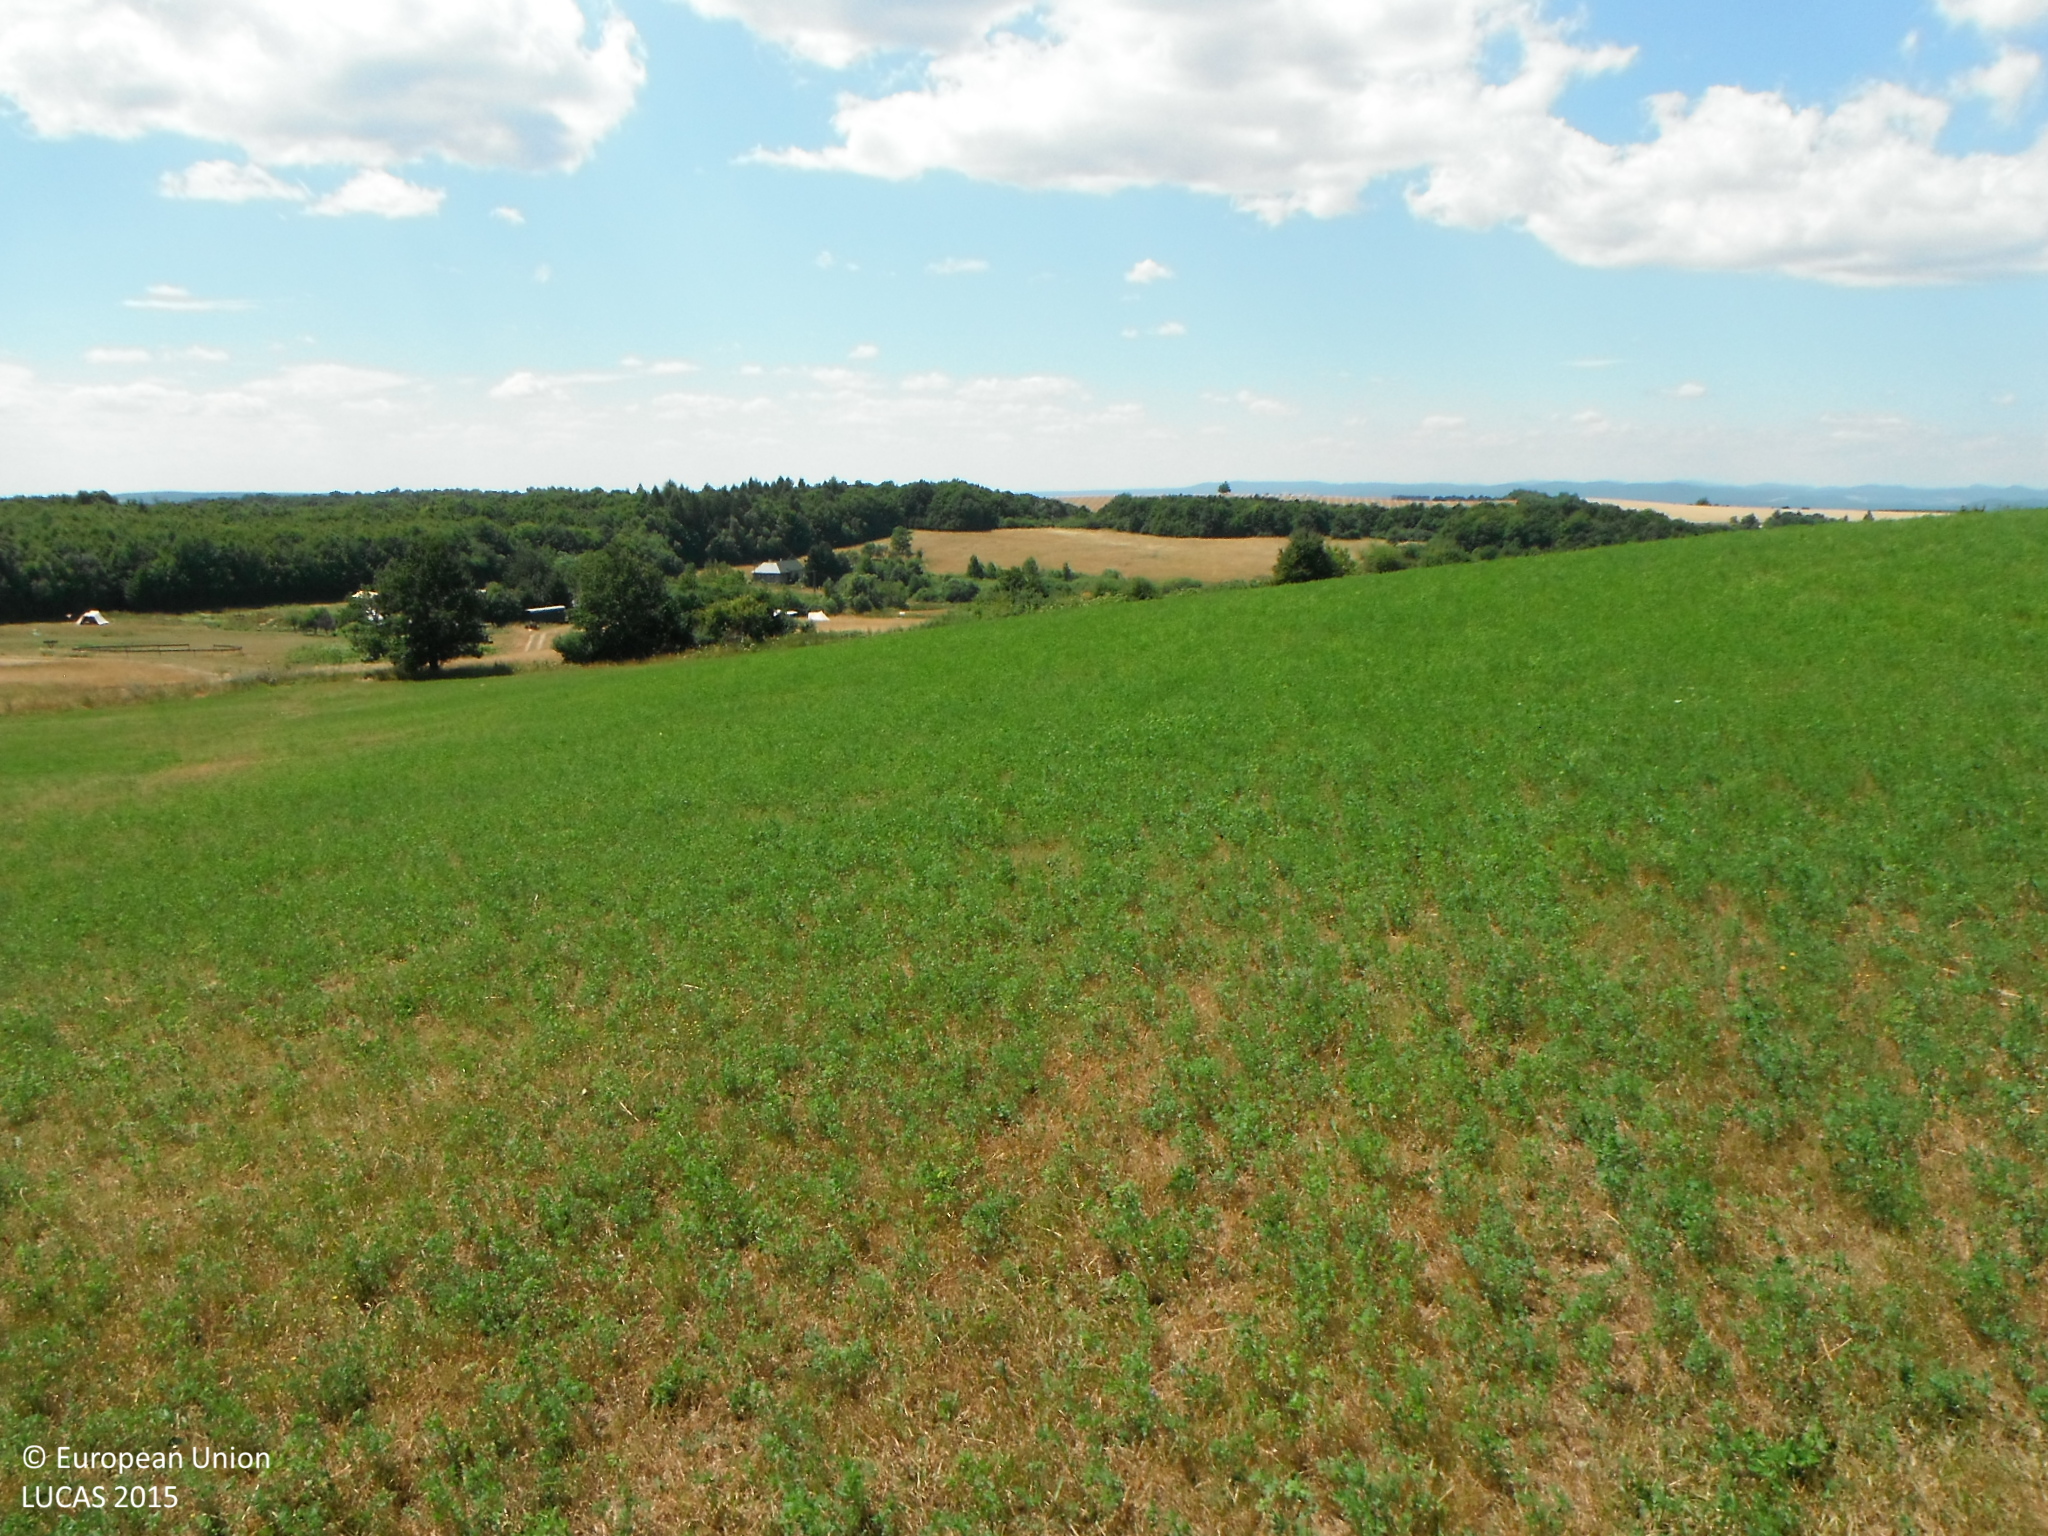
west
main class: Cropland
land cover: Other leguminous and mixtures for fodder
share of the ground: > 75 %
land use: Agriculture (excluding fallow land and kitchen gardens)
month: July
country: SK
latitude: 48.2529
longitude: 19.2207
